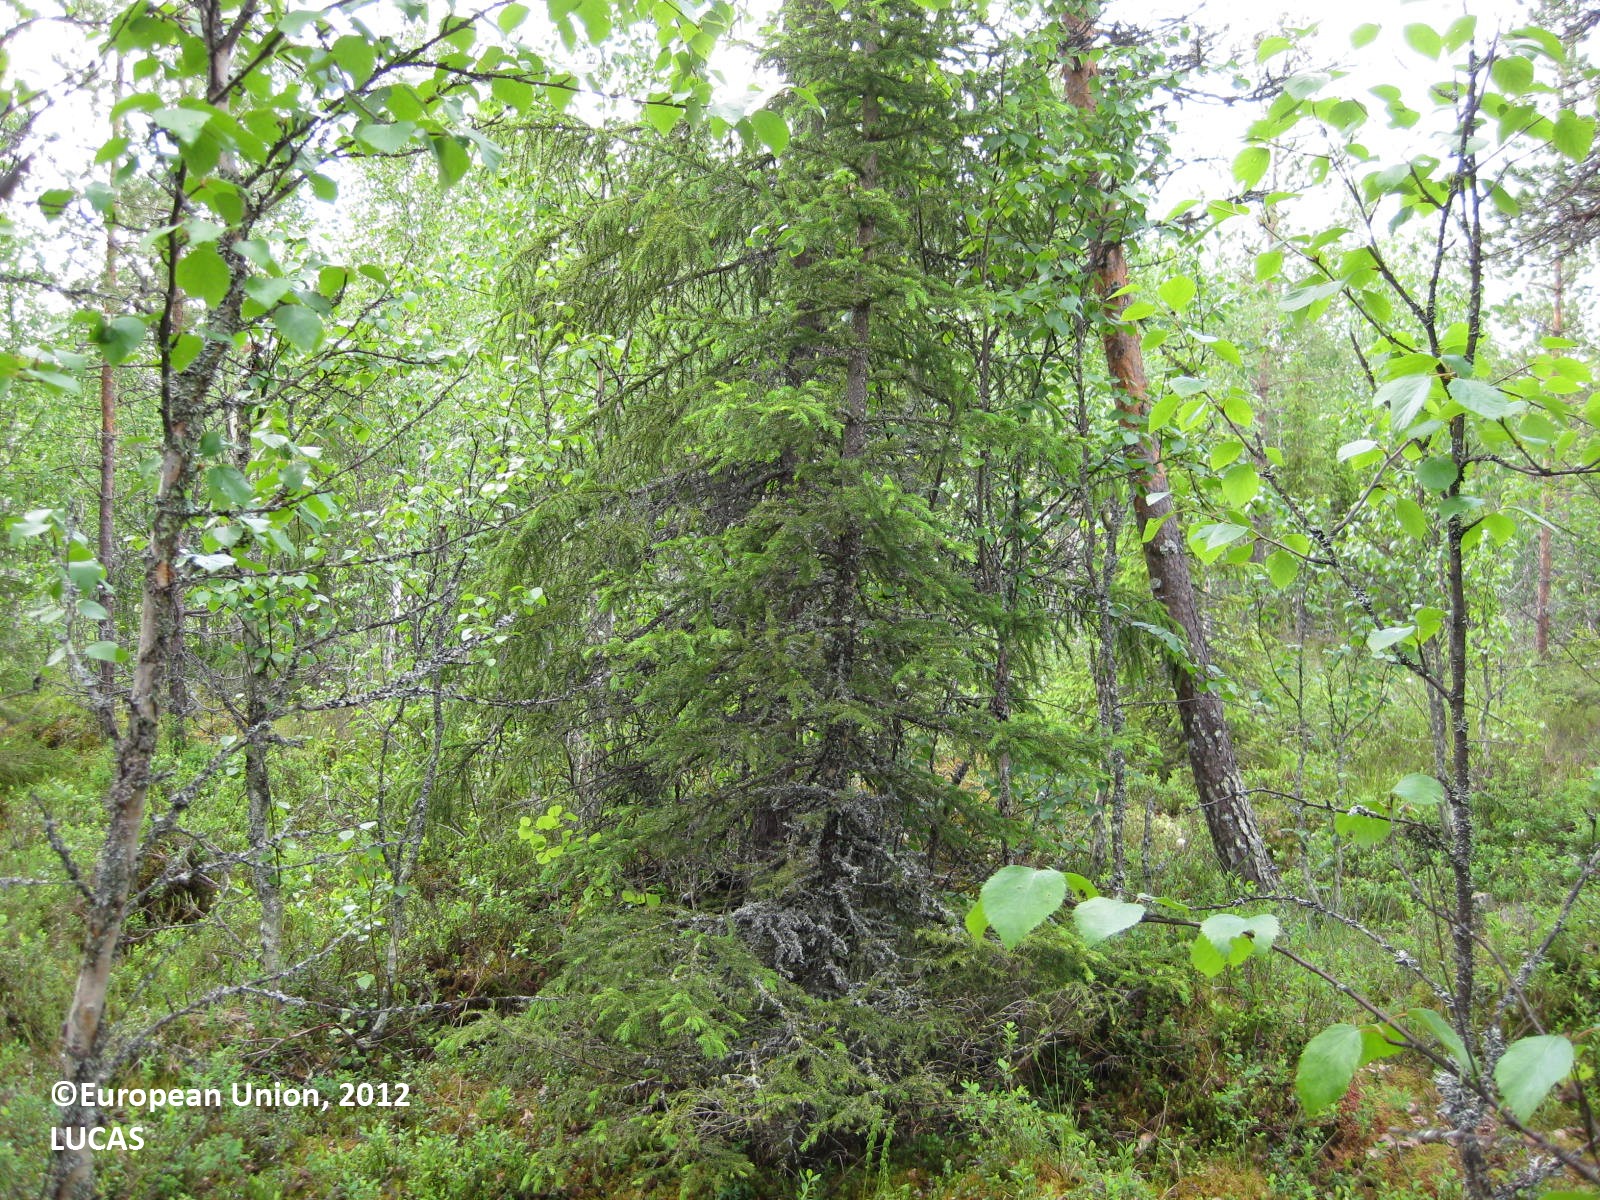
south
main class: Woodland
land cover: Other mixed woodland
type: boreal forest
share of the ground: > 75 %
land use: Forestry
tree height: > 5 m
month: June
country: FI
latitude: 65.1444
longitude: 28.1726
